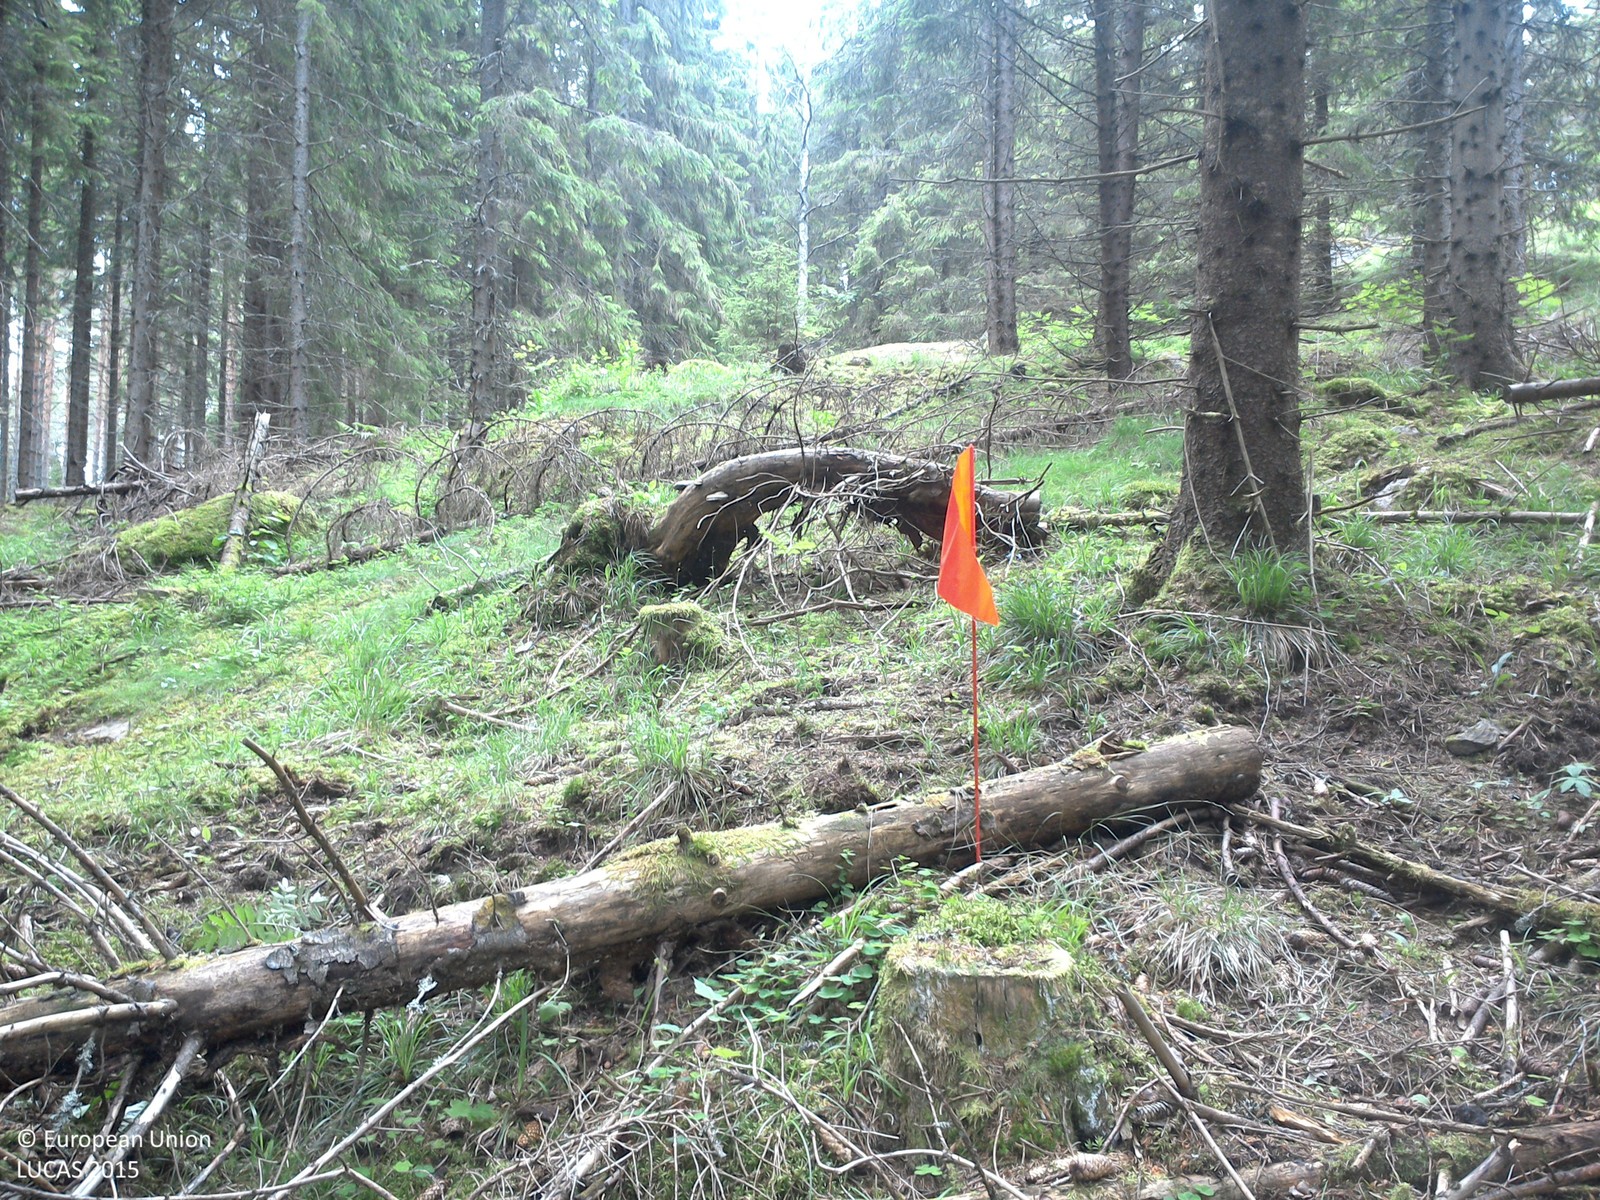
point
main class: Woodland
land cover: Spruce dominated coniferous woodland
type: boreal forest
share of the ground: 50 - 75 %
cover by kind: coniferous forest trees 60 %, lichens and mosses 40 %
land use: Forestry
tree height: > 5 m
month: June
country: SE
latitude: 58.0914
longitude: 15.4402
